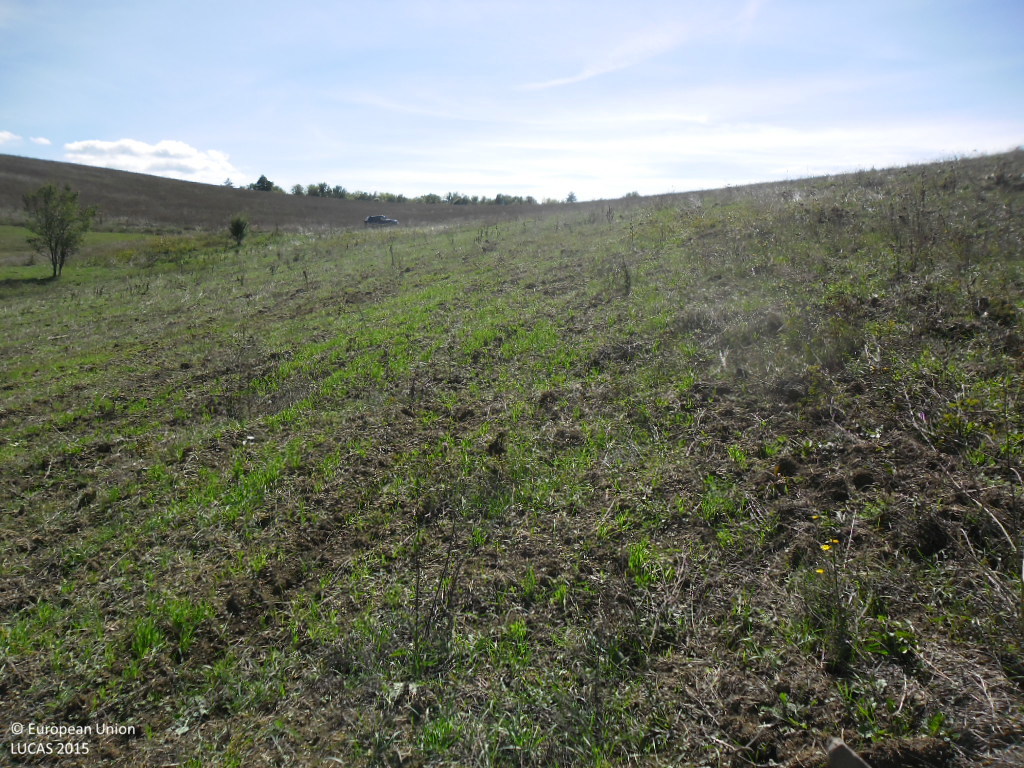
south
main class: Grassland
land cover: Grassland without tree/shrub cover
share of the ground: > 75 %
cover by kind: herbaceous plants 100 %
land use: Agriculture (excluding fallow land and kitchen gardens)
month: October
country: BG
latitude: 42.0405
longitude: 22.7896
